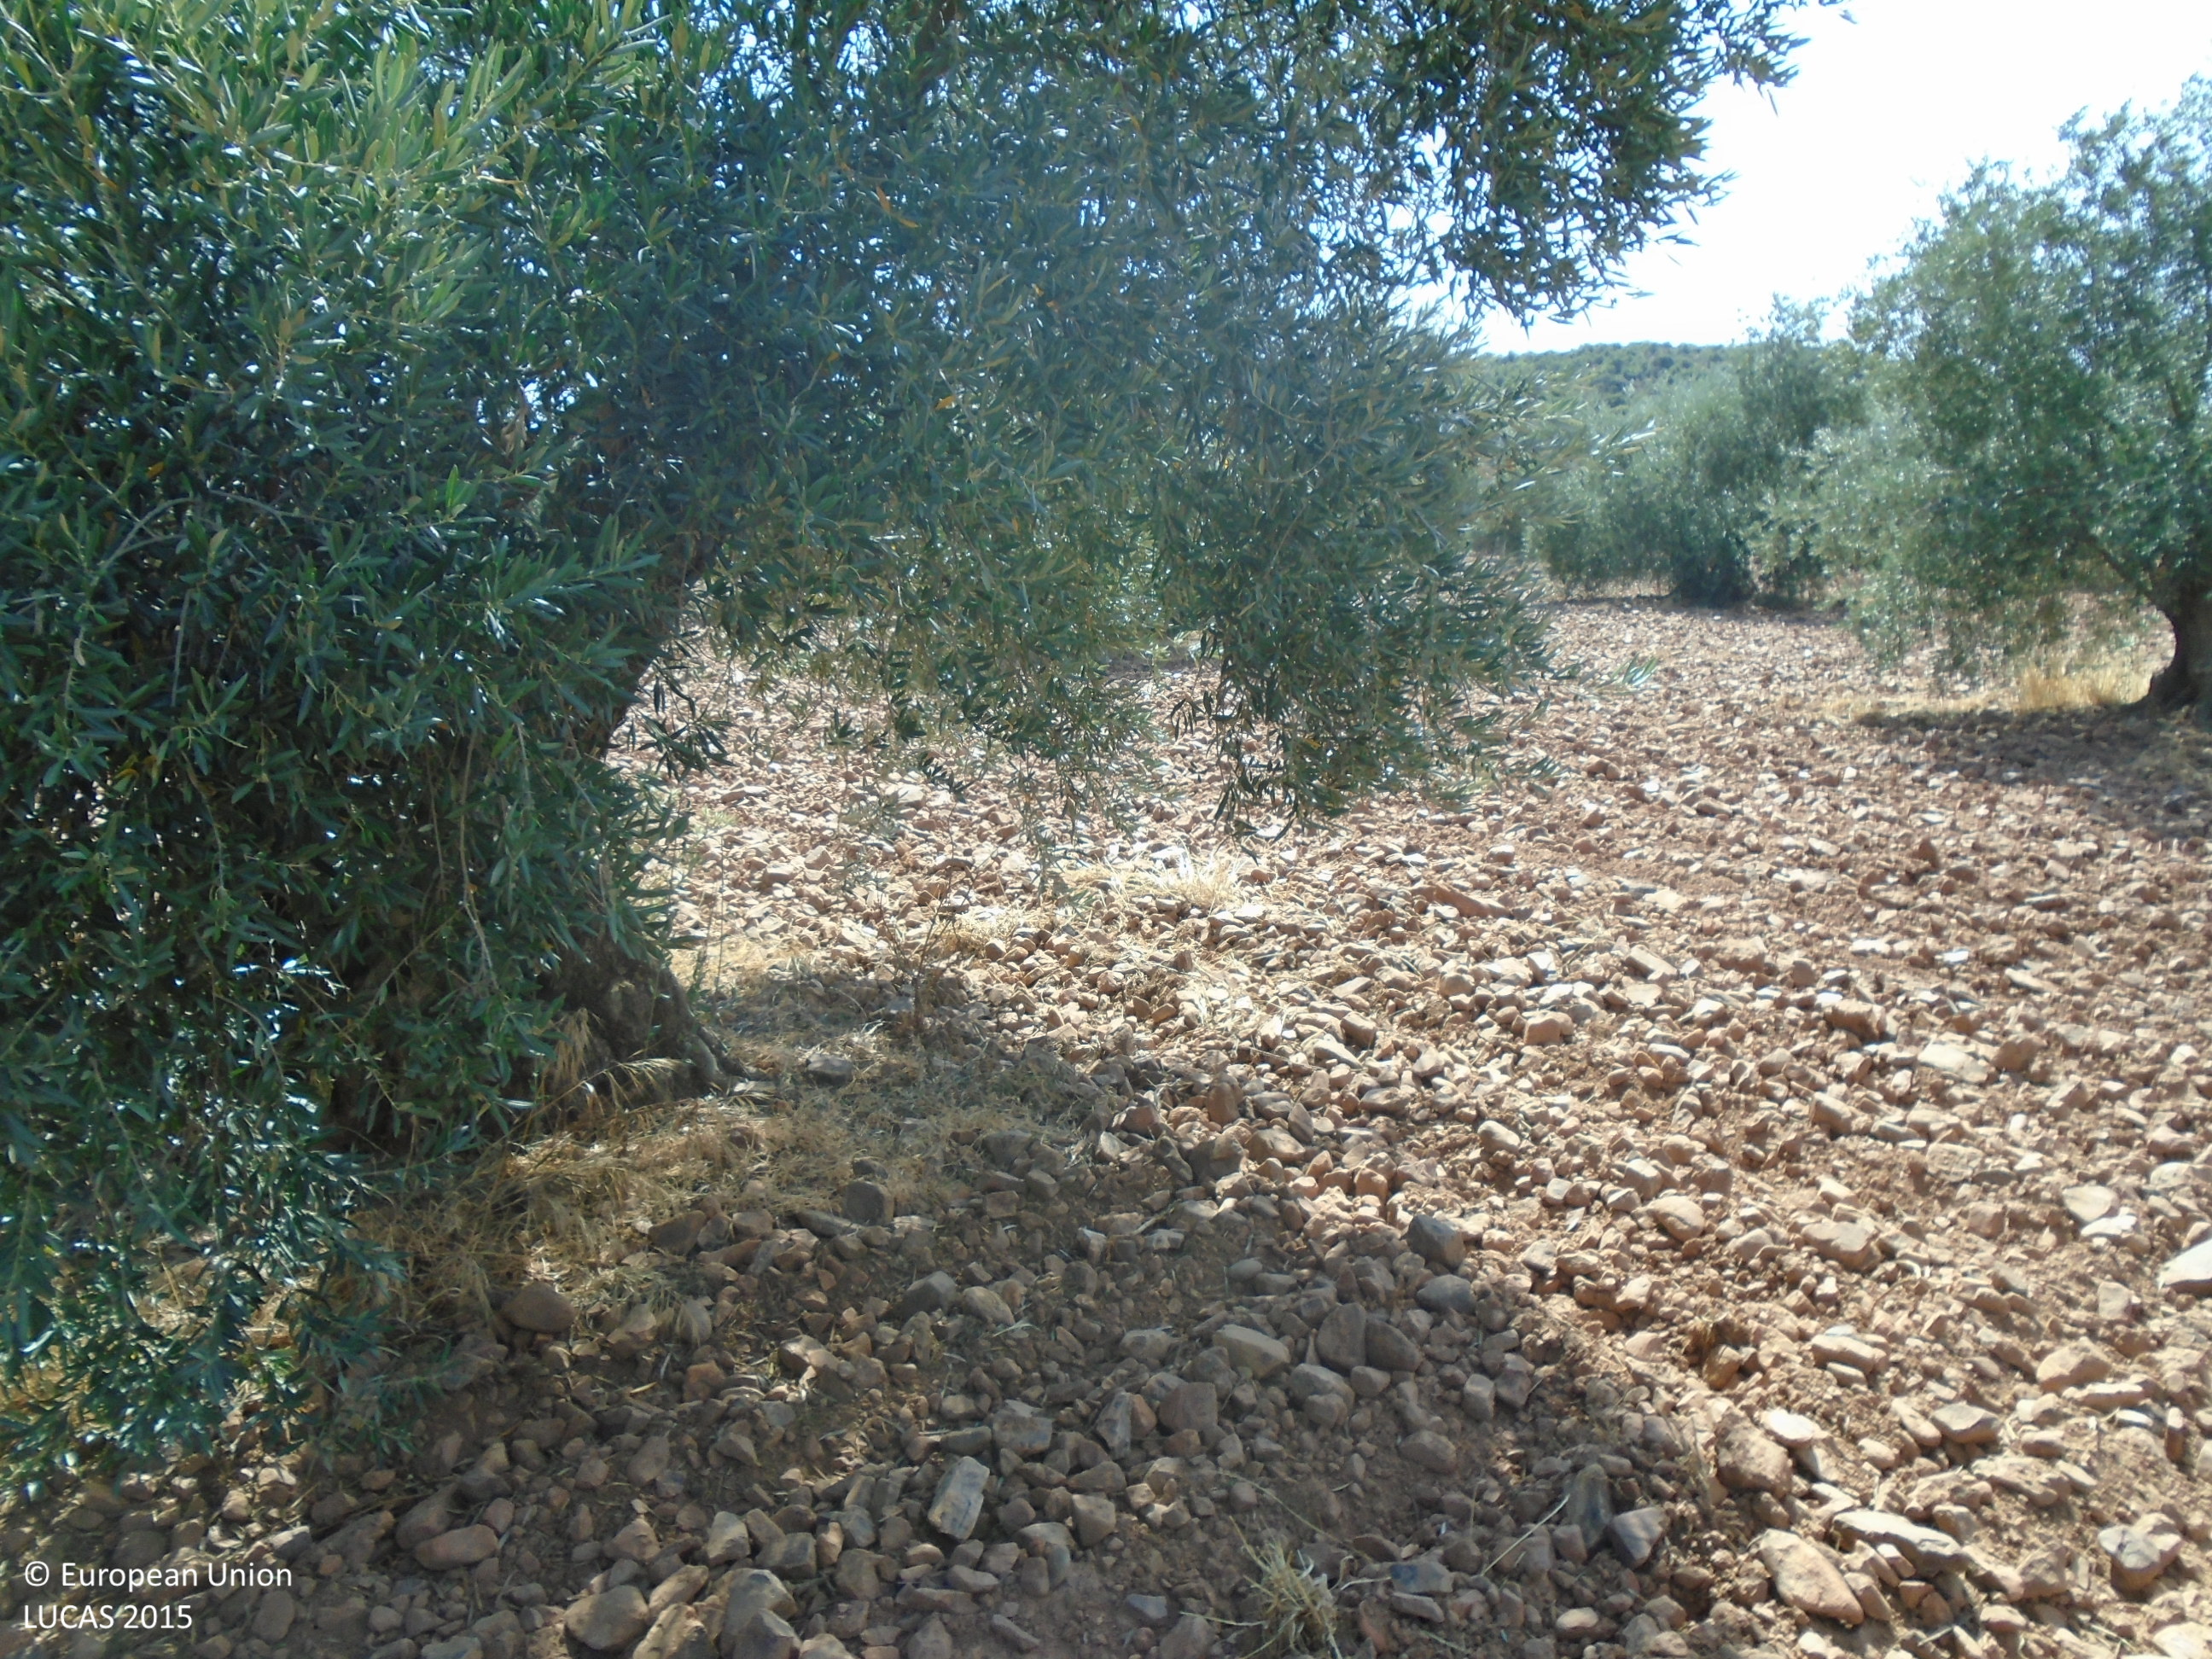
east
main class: Cropland
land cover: Olive groves
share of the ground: 10 - 25 %
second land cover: Other bare soil
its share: > 75 %
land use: Agriculture (excluding fallow land and kitchen gardens)
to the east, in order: Olive groves; Other bare soil; Grass margins; Fences; Grass margins; Other bare soil
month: June
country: ES
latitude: 39.3101
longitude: -3.5080
